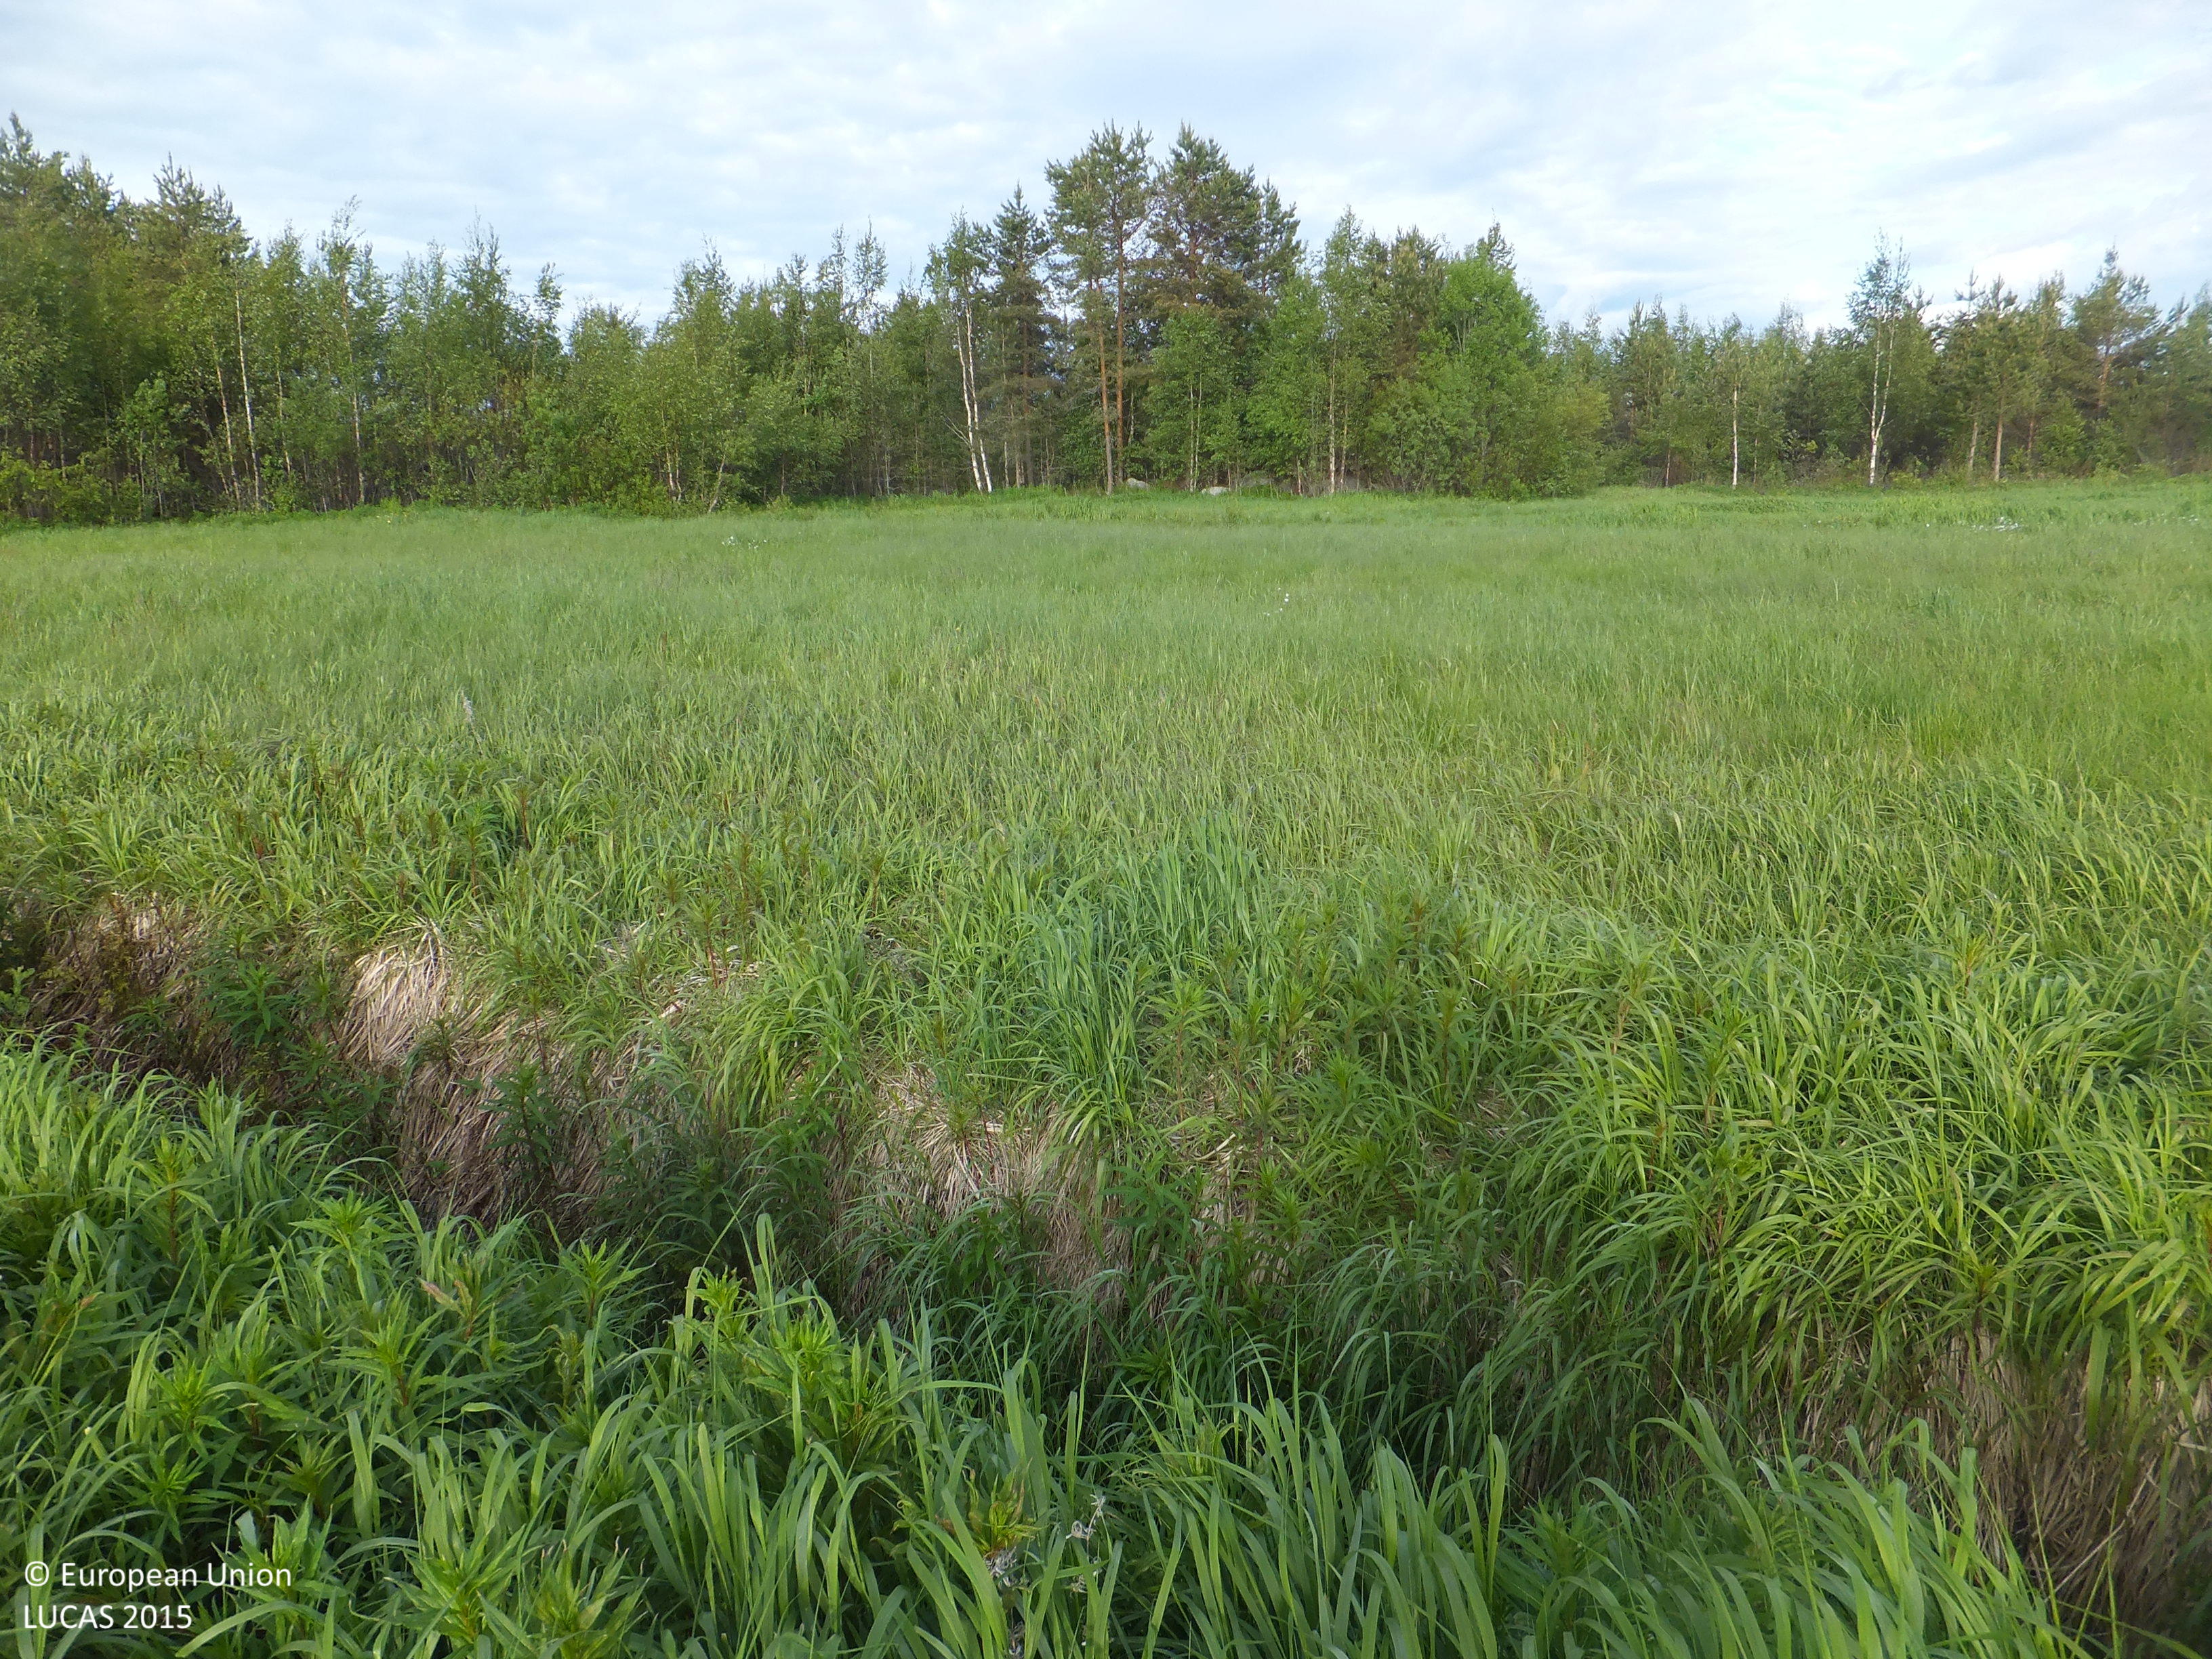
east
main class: Cropland
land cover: Temporary grasslands
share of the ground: > 75 %
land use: Agriculture (excluding fallow land and kitchen gardens)
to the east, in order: Temporary grasslands; Ditches and canals; Temporary grasslands; Ditches and canals; Temporary grasslands; Spontaneously vegetated surfaces; Lines of trees; Ditches and canals; Pine dominated mixed woodland; Grass margins; Tracks; Ditches and canals; Pine dominated mixed woodland; Grassland without tree/shrub cover; Ditches and canals; Temporary grasslands; Ditches and canals; Temporary grasslands; Ditches and canals; Temporary grasslands; Ditches and canals; Temporary grasslands; Ditches and canals; Temporary grasslands; Ditches and canals; Temporary grasslands
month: June
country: FI
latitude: 63.6777
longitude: 24.2428
